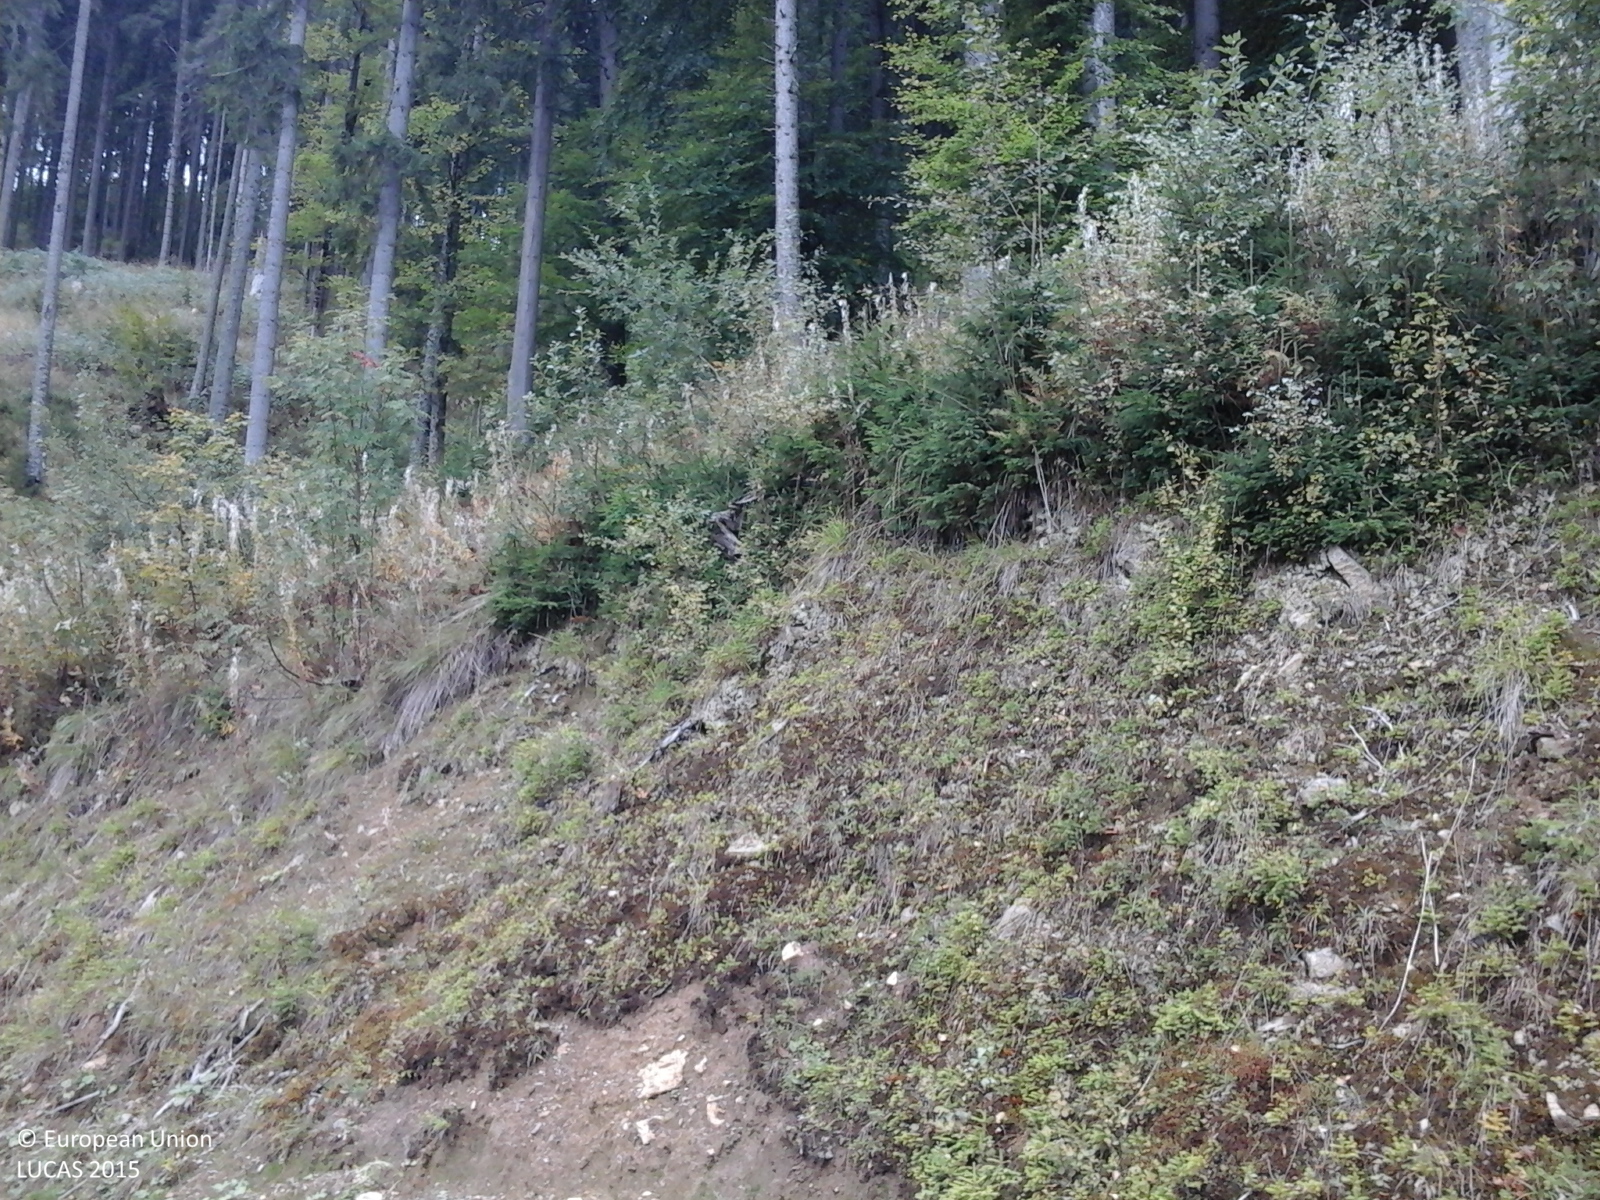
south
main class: Grassland
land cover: Spontaneously vegetated surfaces
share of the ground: > 75 %
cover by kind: herbaceous plants 100 %
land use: Forestry
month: September
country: RO
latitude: 45.6709
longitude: 23.6589
